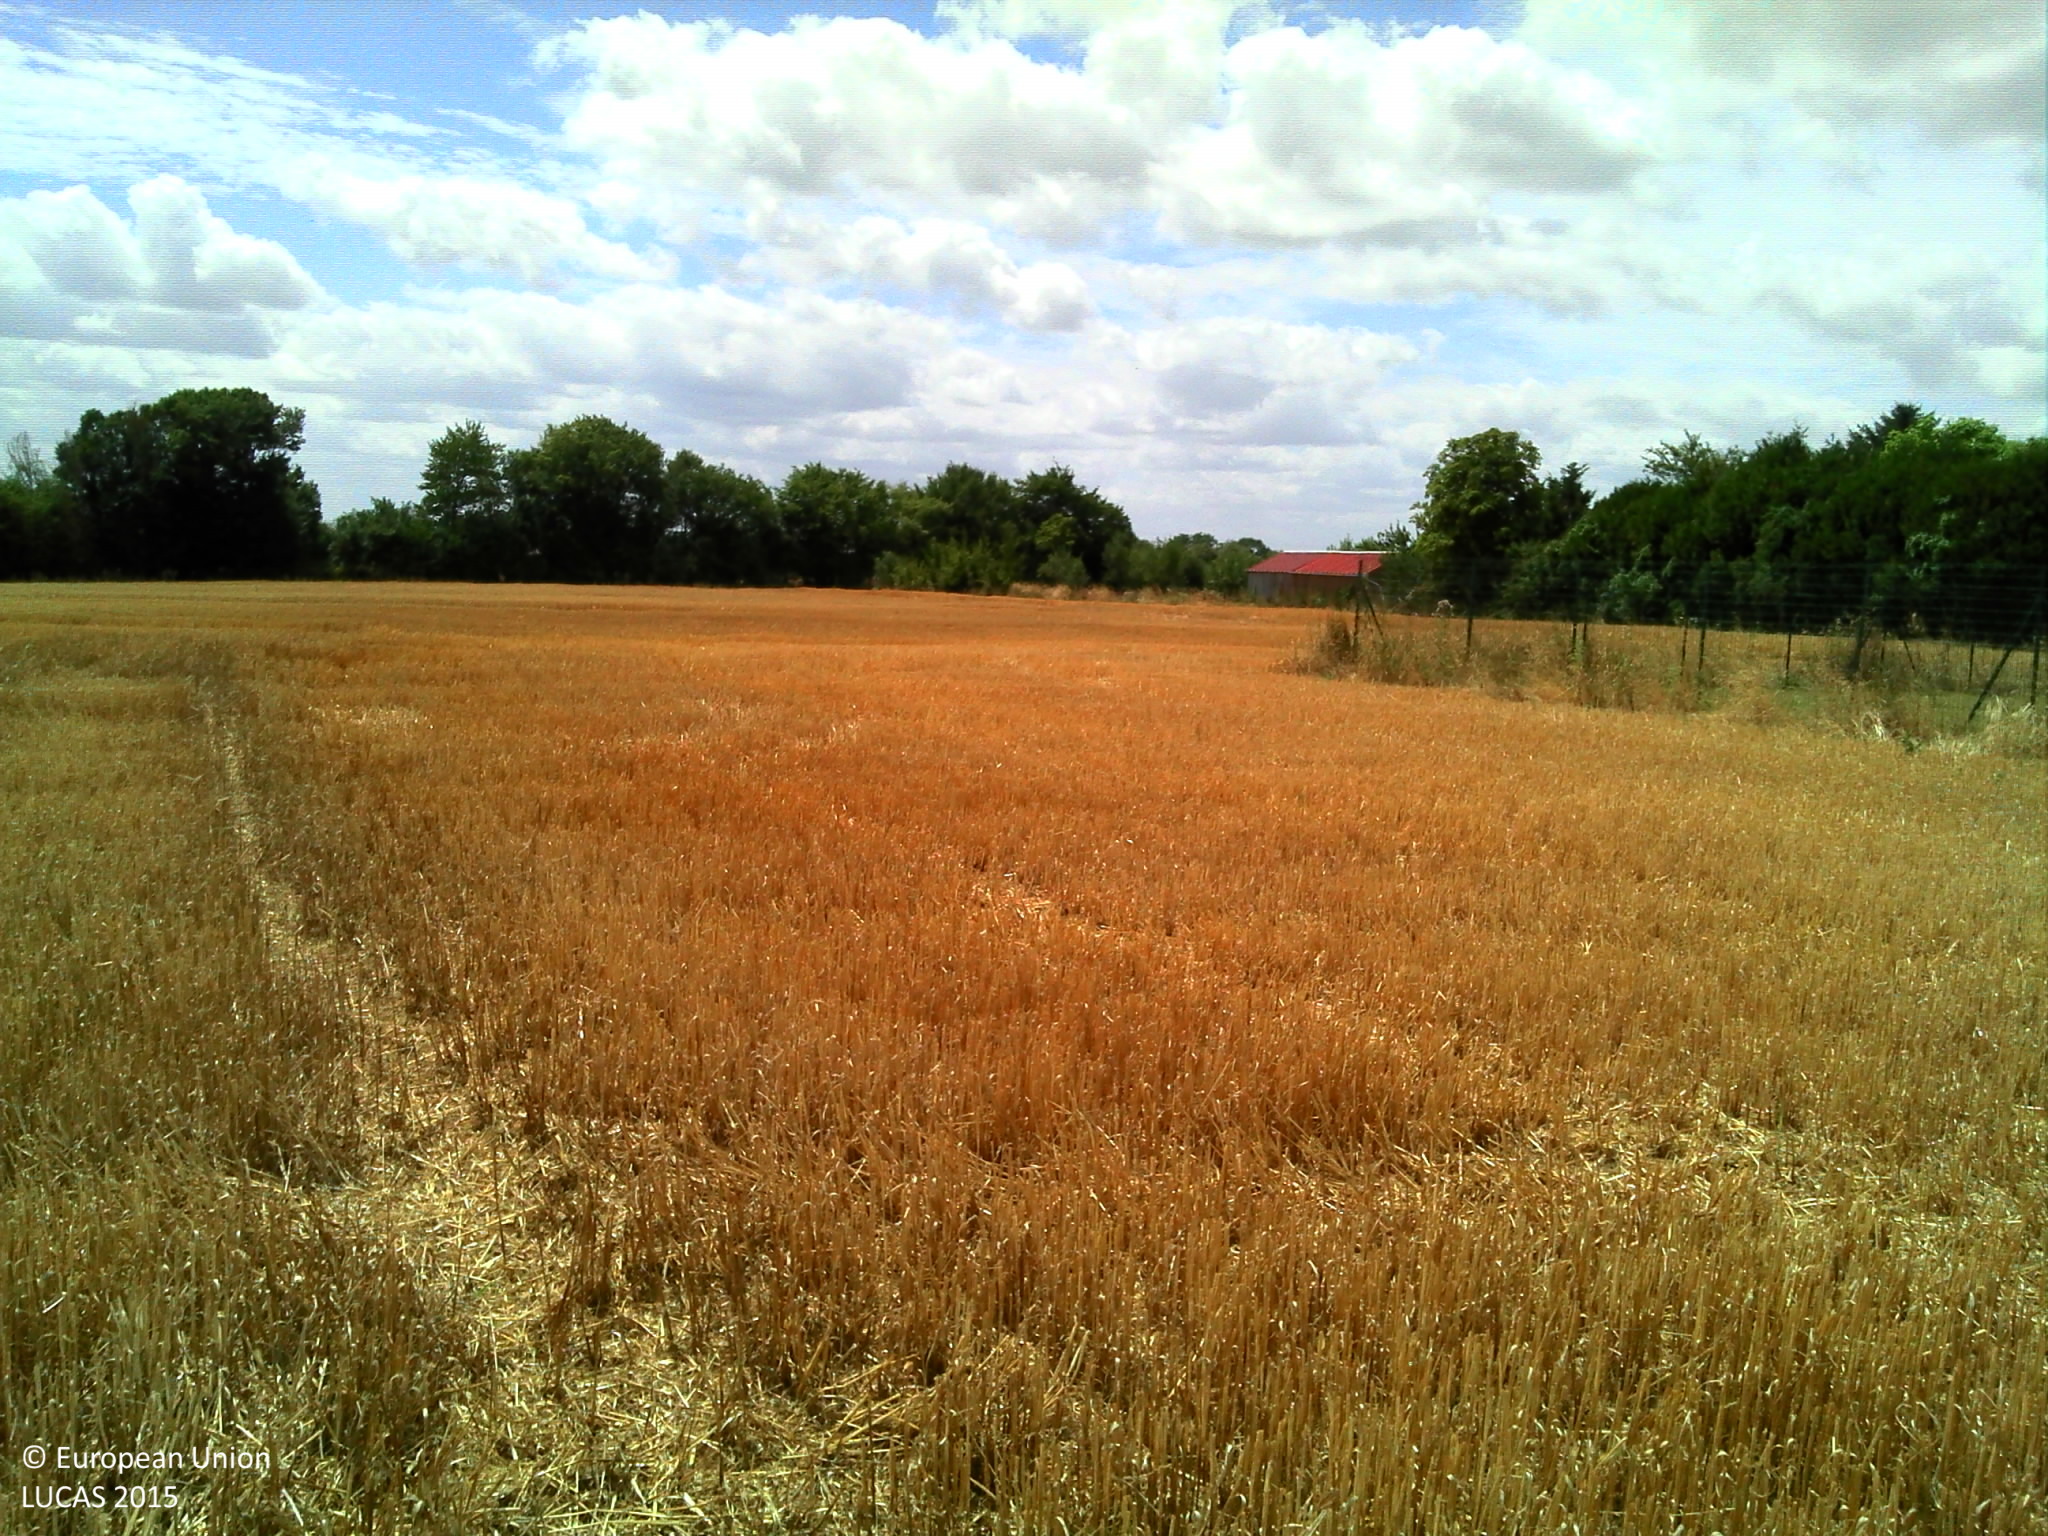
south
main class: Cropland
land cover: Barley
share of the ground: > 75 %
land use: Agriculture (excluding fallow land and kitchen gardens)
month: July
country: FR
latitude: 47.8813
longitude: 3.1071
